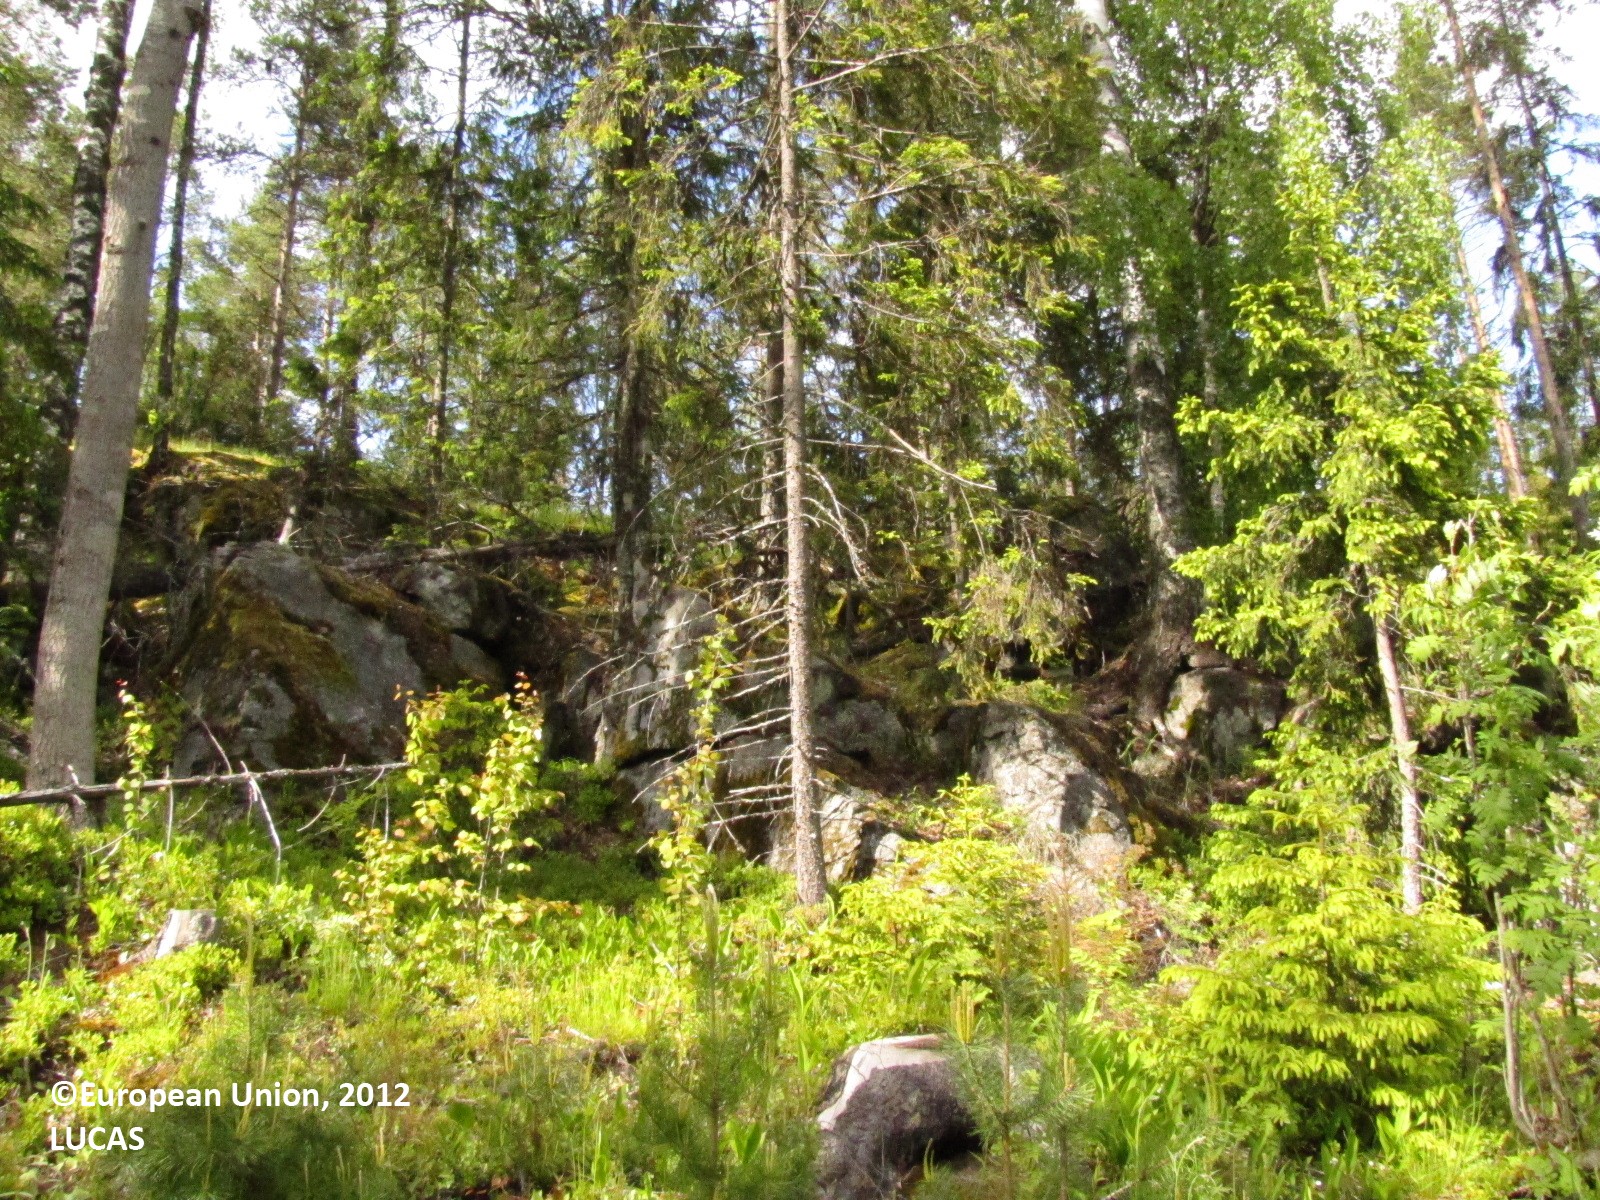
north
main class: Woodland
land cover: Broadleaved woodland
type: hemiboreal forest and nemoral coniferous forest and mixed broadleaved-coniferous forest
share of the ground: 50 - 75 %
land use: Forestry
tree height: < 5 m
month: June
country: FI
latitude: 61.5272
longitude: 23.0648
